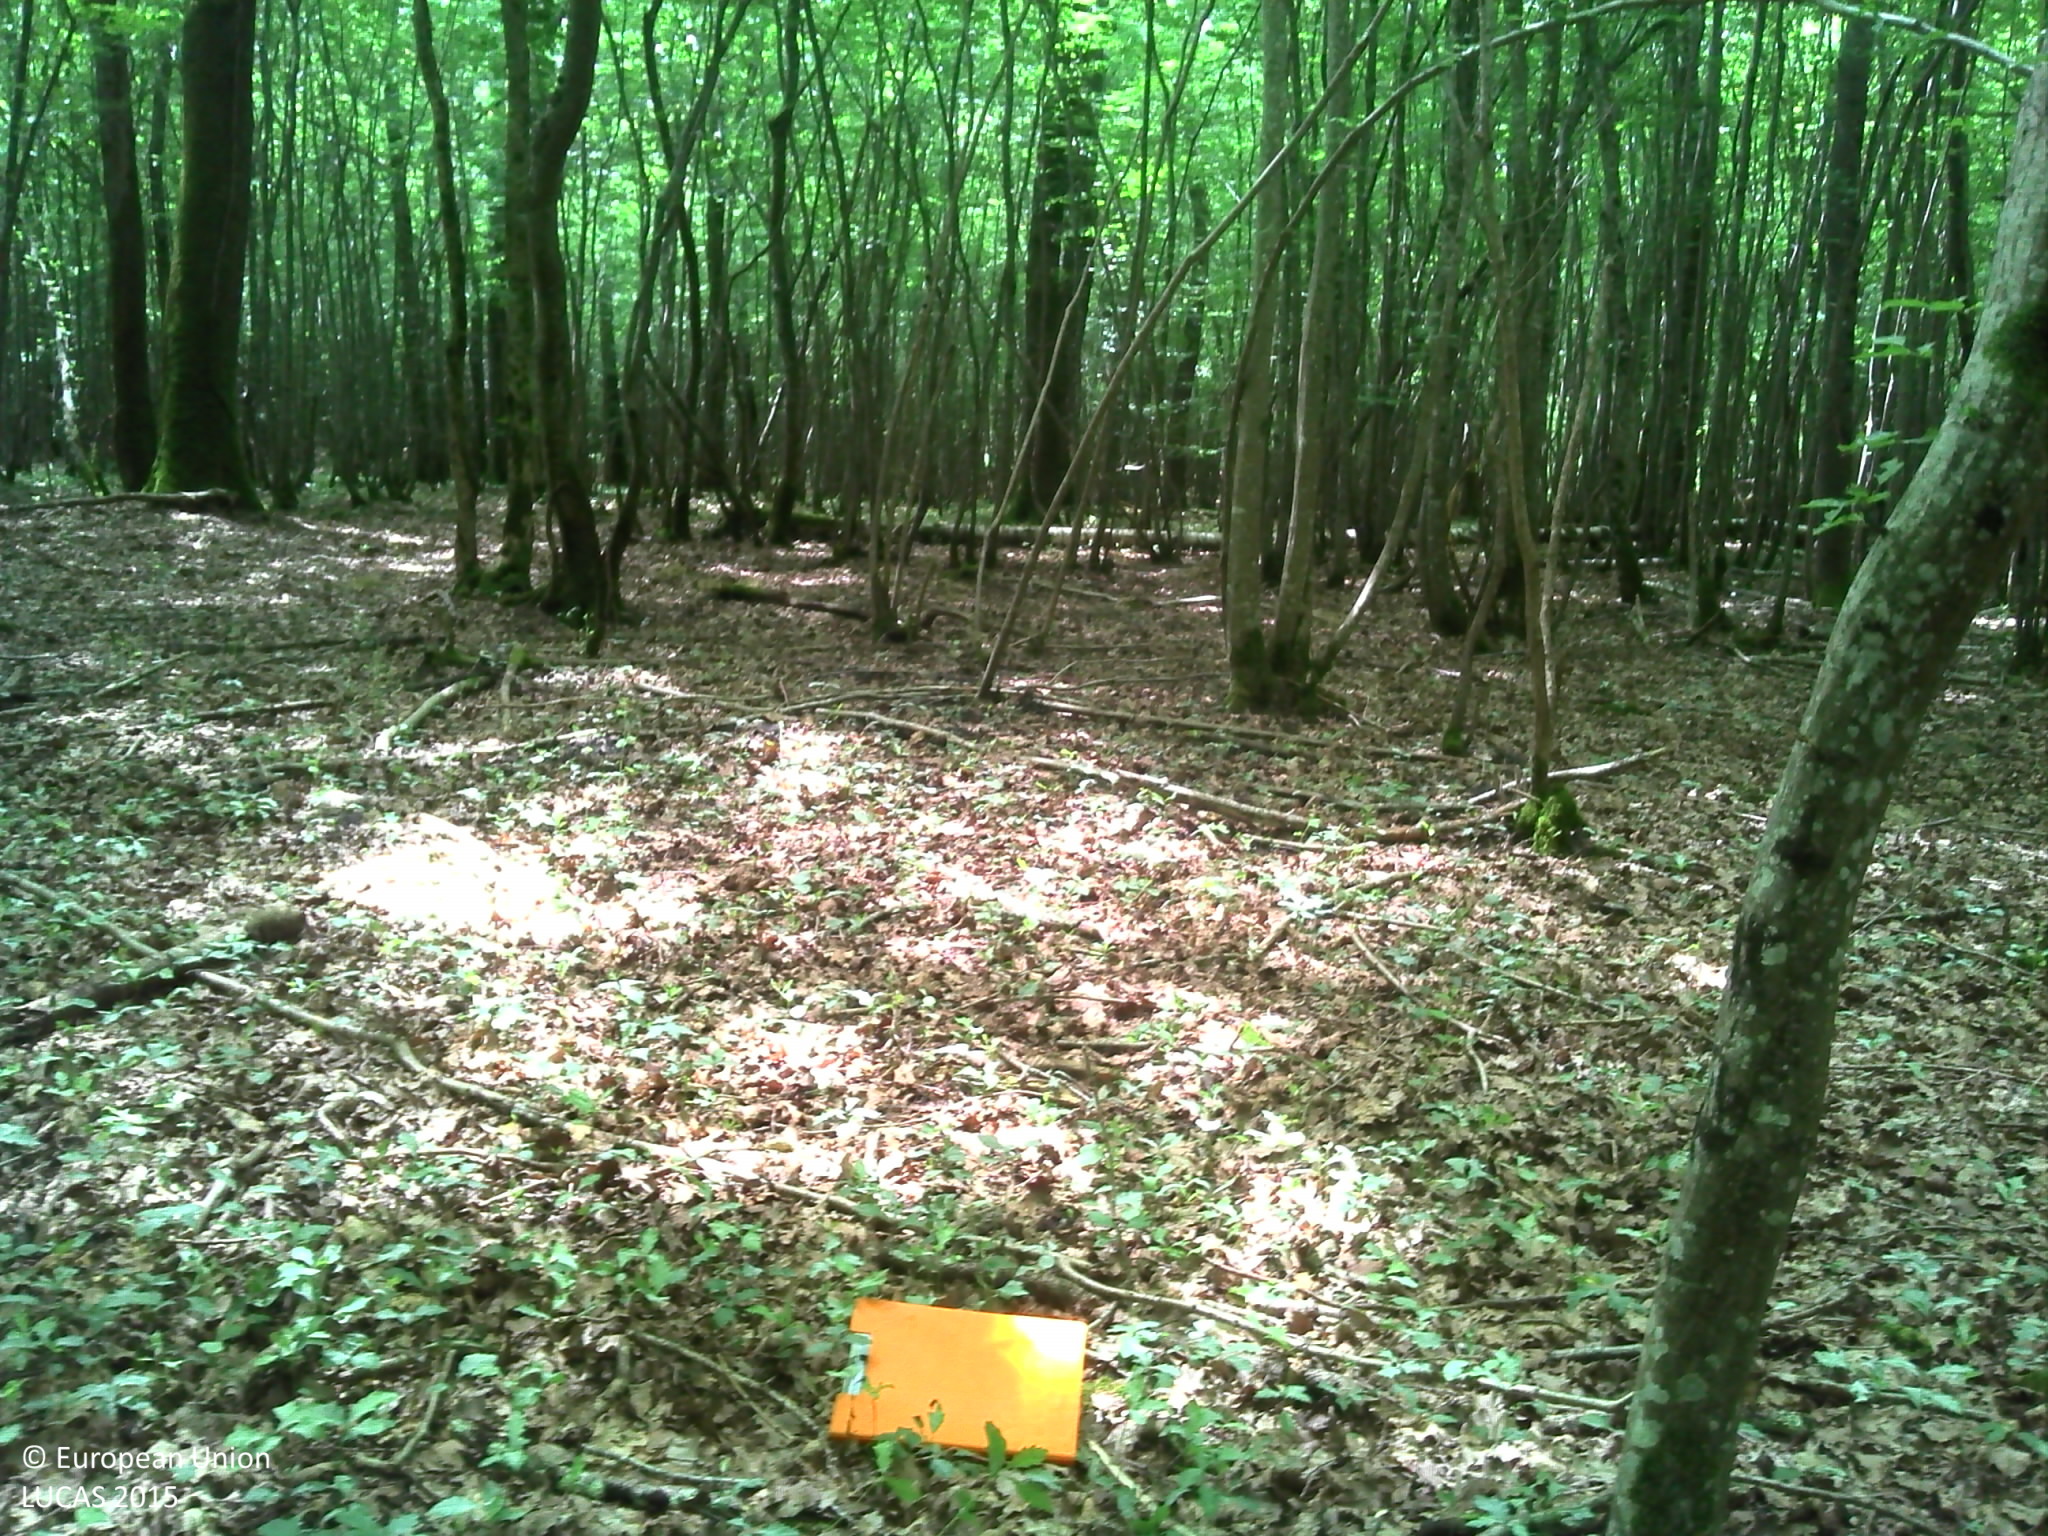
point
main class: Woodland
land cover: Broadleaved woodland
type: mesophytic deciduous forest
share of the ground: > 75 %
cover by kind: broadleaved forest trees 100 %
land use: Forestry
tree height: > 5 m
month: June
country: FR
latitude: 47.0601
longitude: 2.9780
